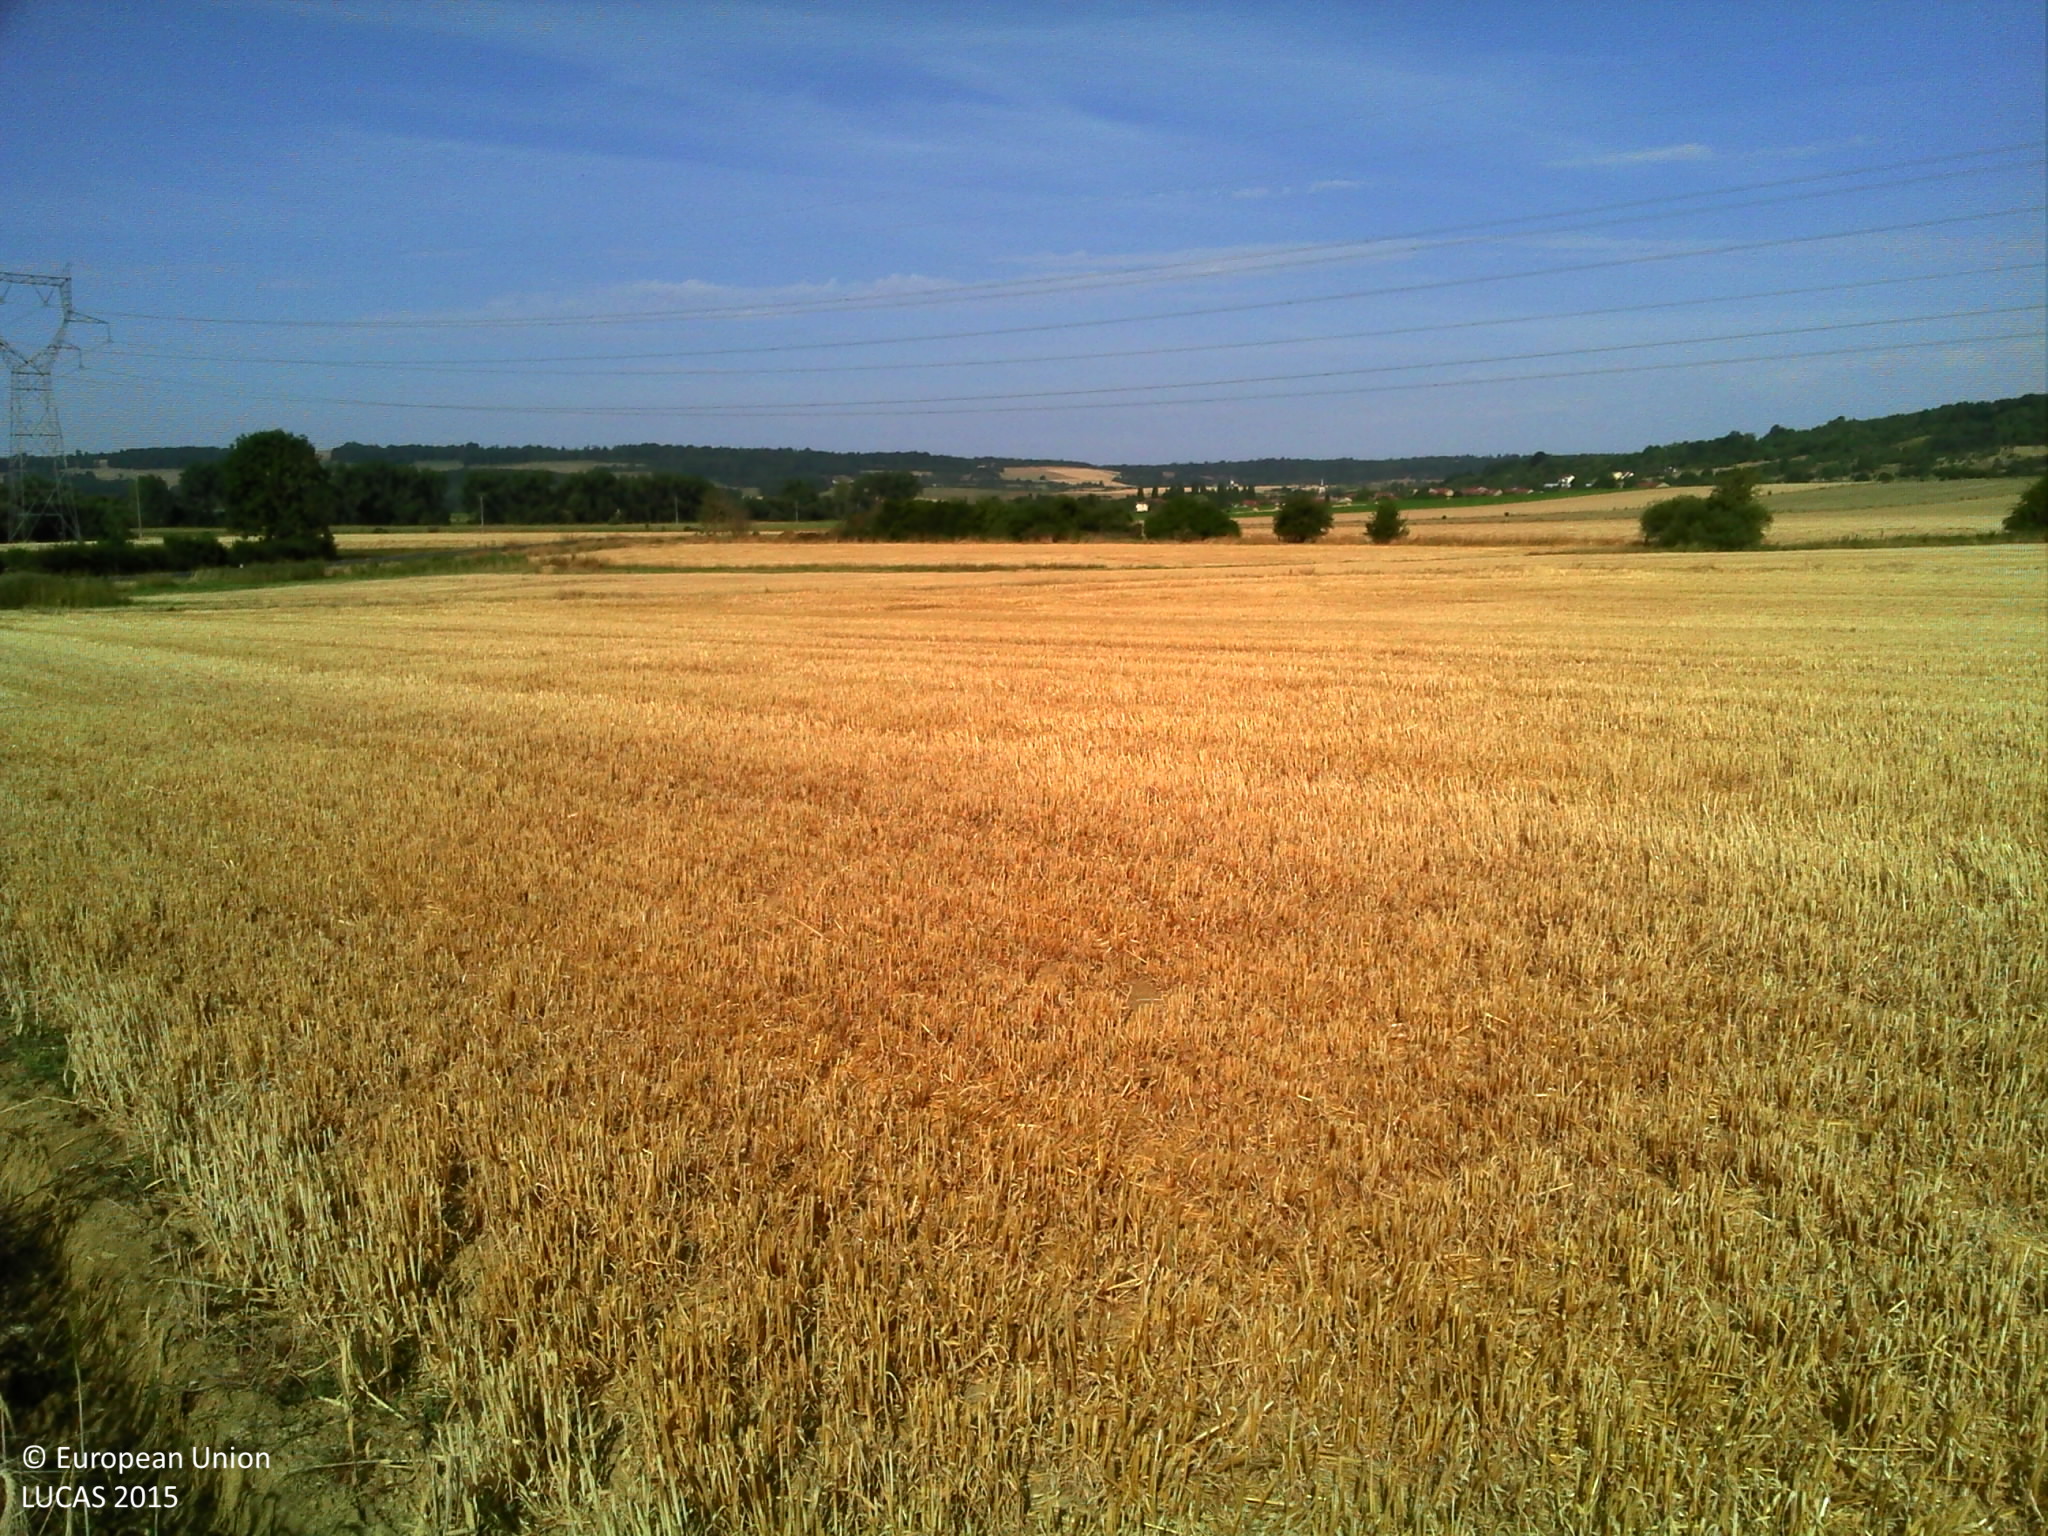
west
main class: Cropland
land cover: Barley
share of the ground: > 75 %
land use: Agriculture (excluding fallow land and kitchen gardens)
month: July
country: FR
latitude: 48.4946
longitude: 6.0351
